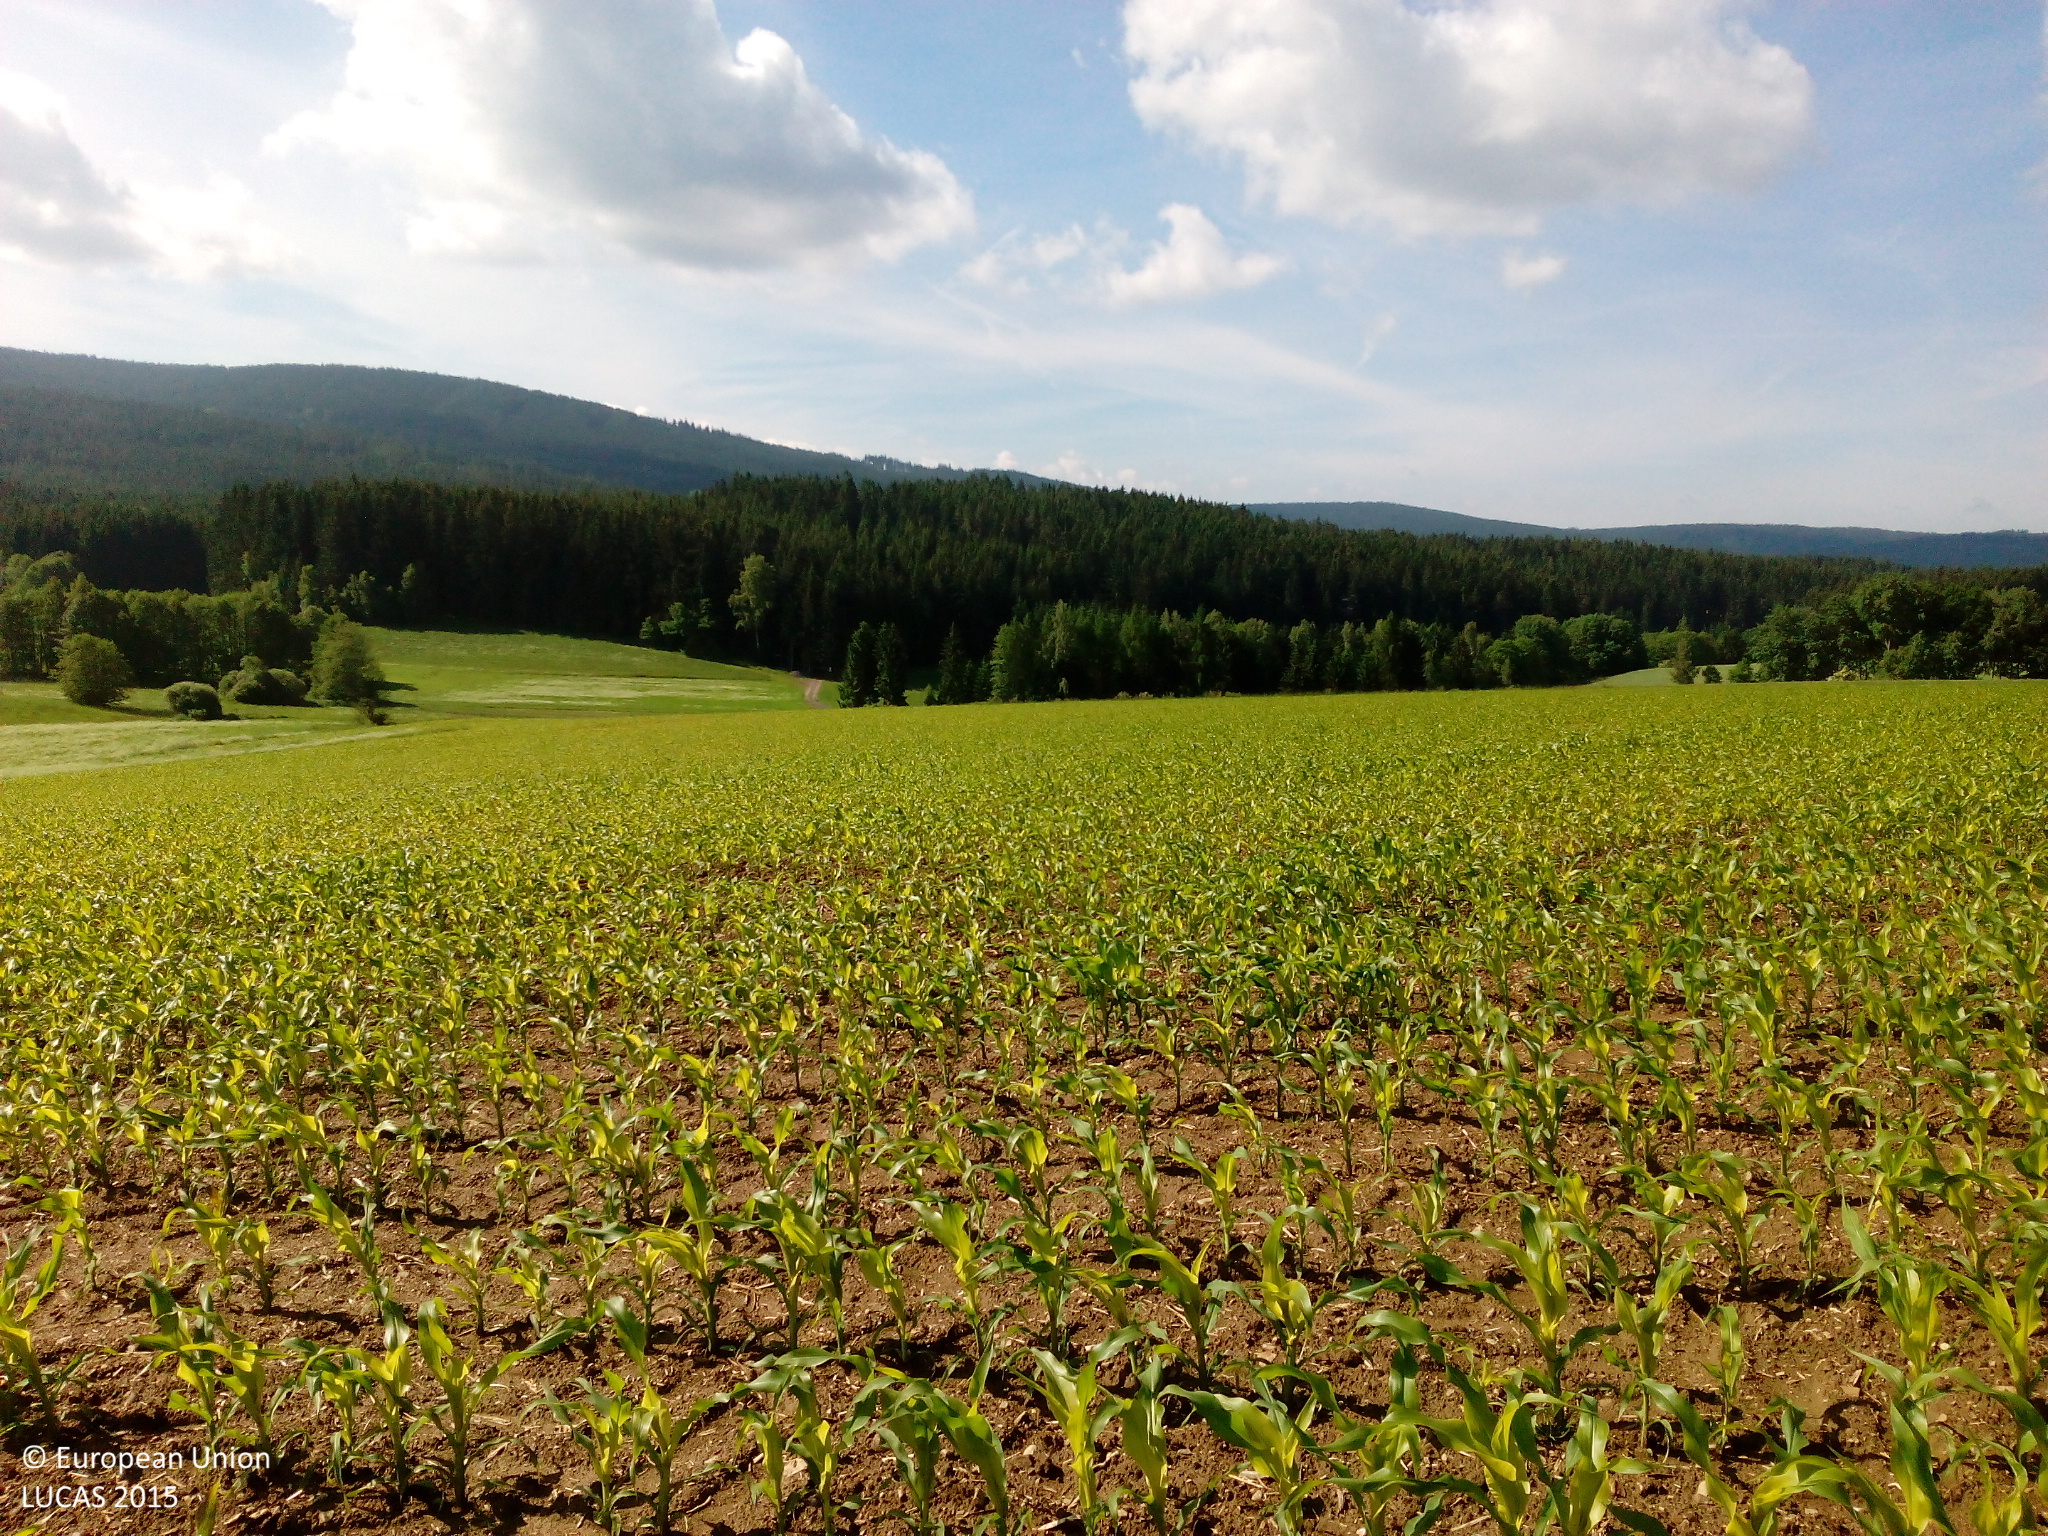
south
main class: Cropland
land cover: Maize
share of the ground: 25 - 50 %
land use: Agriculture (excluding fallow land and kitchen gardens)
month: June
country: DE
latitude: 49.9776
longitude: 12.4679
